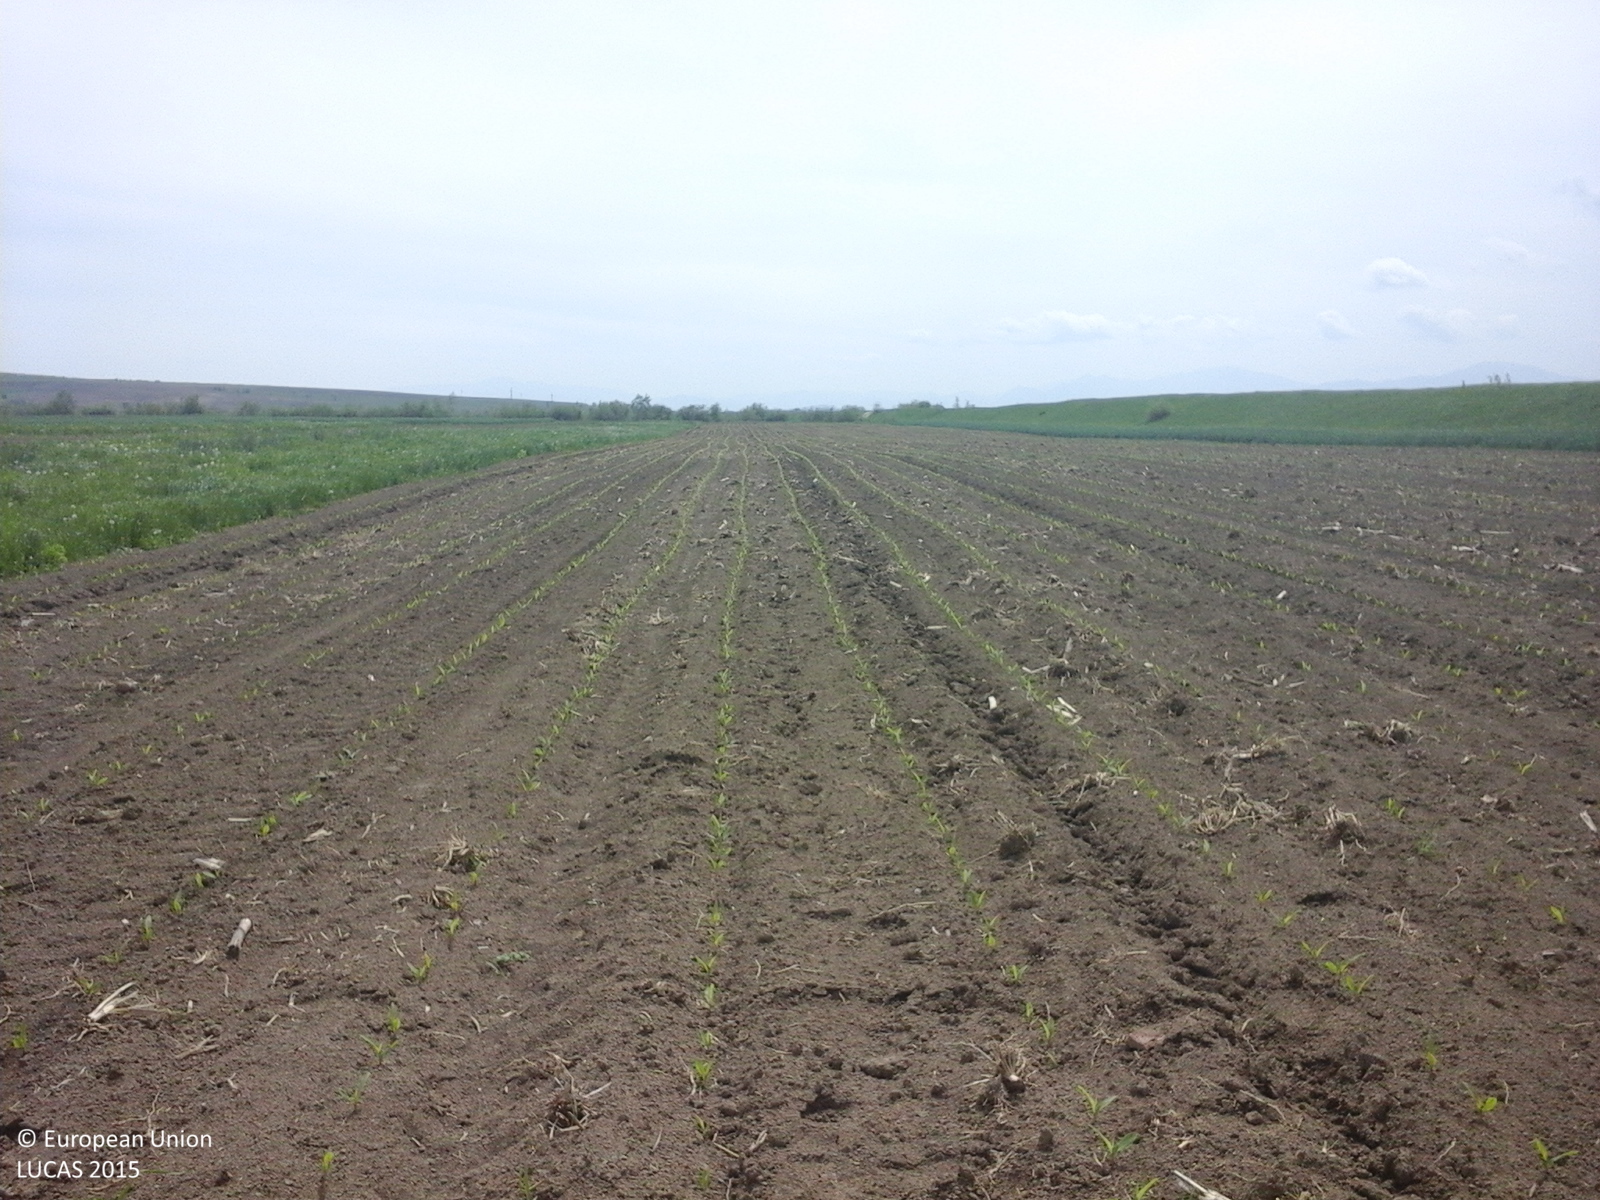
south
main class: Cropland
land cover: Maize
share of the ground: < 10 %
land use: Agriculture (excluding fallow land and kitchen gardens)
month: May
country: RO
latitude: 45.8827
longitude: 25.5547
